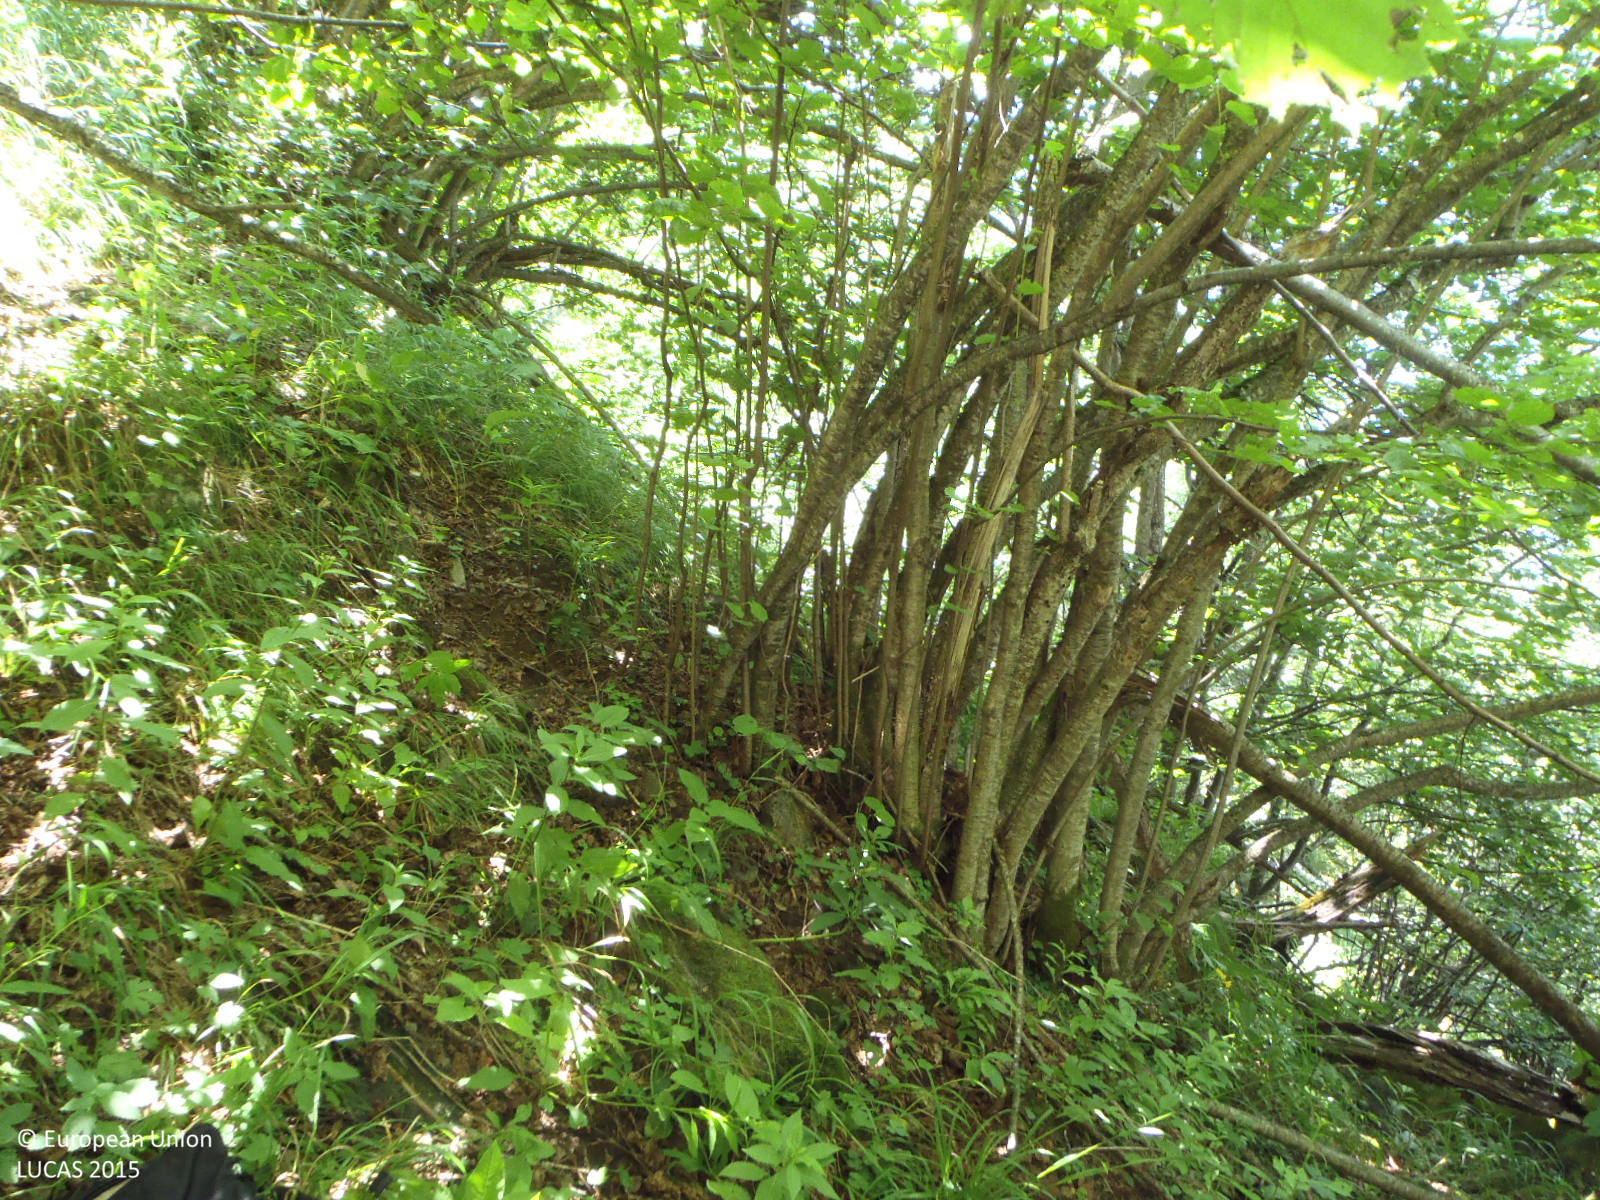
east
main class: Woodland
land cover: Broadleaved woodland
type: mountainous beech forest
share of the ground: > 75 %
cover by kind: broadleaved forest trees 75 %, coniferous forest trees 15 %, herbaceous plants 5 %, consolidated bare surface 5 %
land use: Forestry
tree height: > 5 m
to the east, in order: Broadleaved woodland; Spruce dominated mixed woodland; Grassland with sparse tree/shrub cover; Broadleaved woodland; Spruce dominated mixed woodland; Grassland with sparse tree/shrub cover
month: July
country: AT
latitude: 47.0930
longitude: 11.7768
